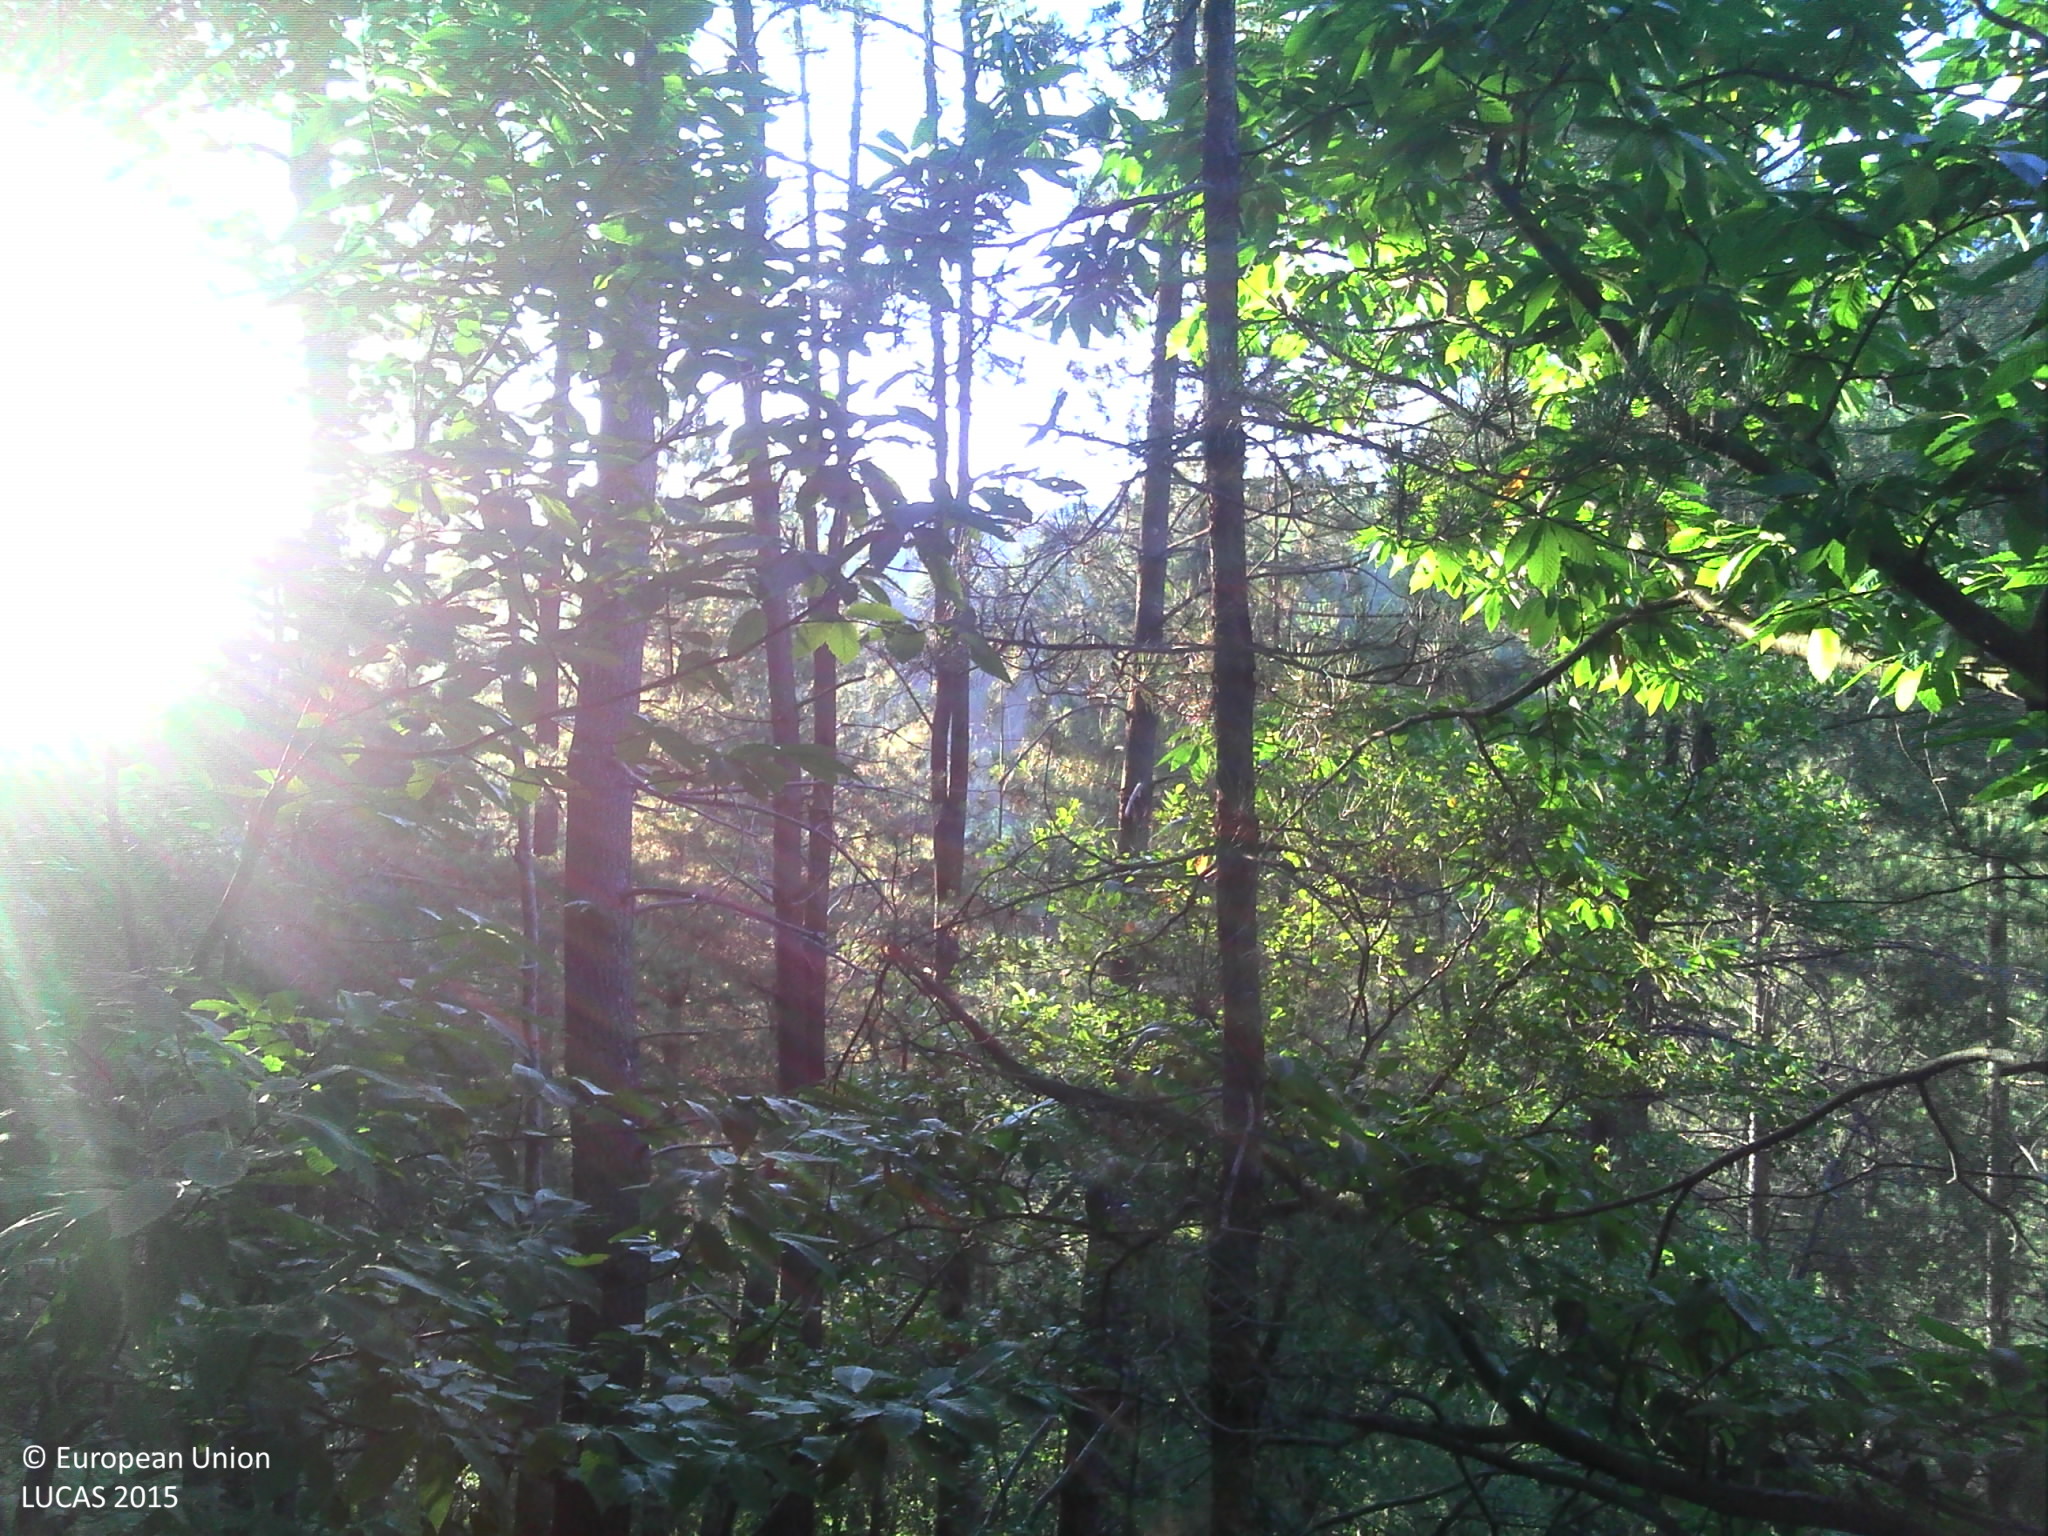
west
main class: Woodland
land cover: Pine dominated mixed woodland
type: coniferous forest of the mediterranean region
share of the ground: > 75 %
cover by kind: broadleaved forest trees 75 %, coniferous forest trees 25 %
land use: Forestry
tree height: > 5 m
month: June
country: FR
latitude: 44.2633
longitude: 3.9315
